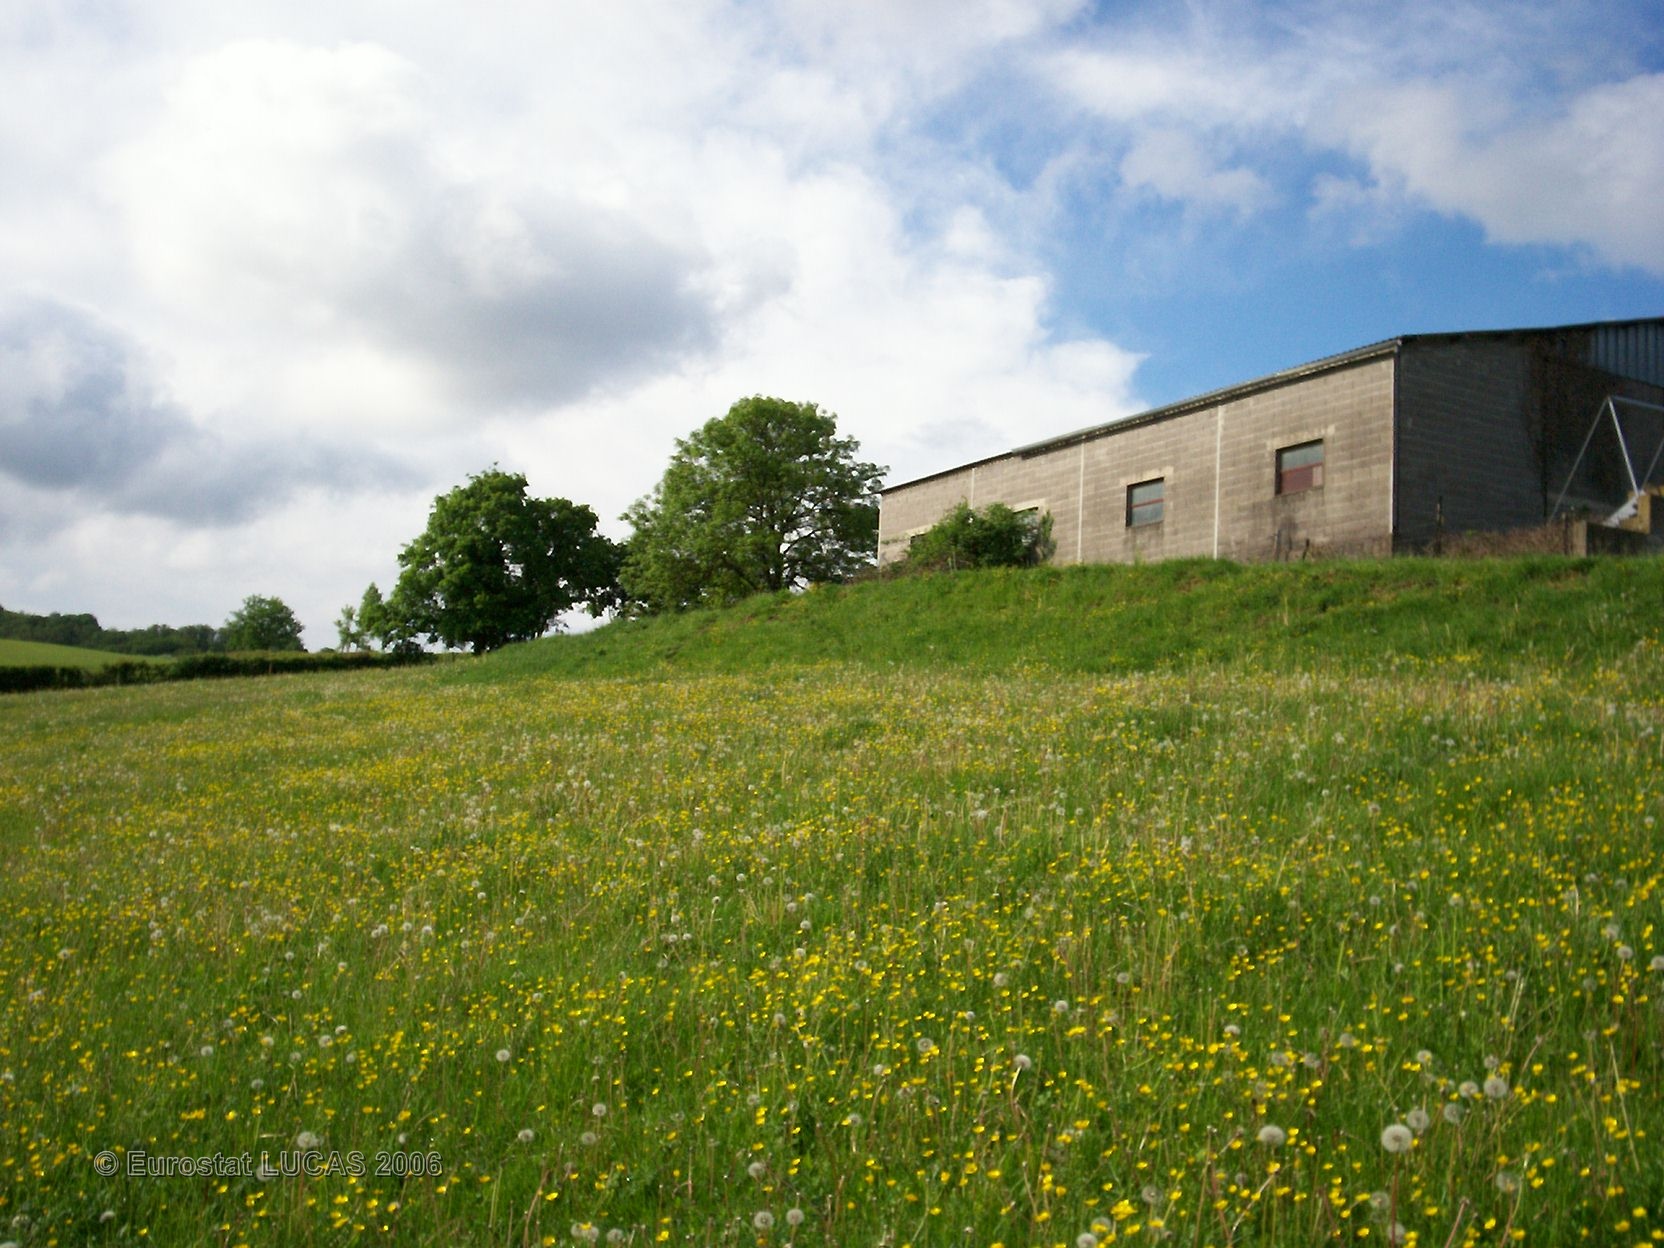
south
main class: Grassland
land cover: Grassland without tree/shrub cover
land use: Agriculture (excluding fallow land and kitchen gardens)
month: May
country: FR
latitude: 45.8618
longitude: 4.7609
